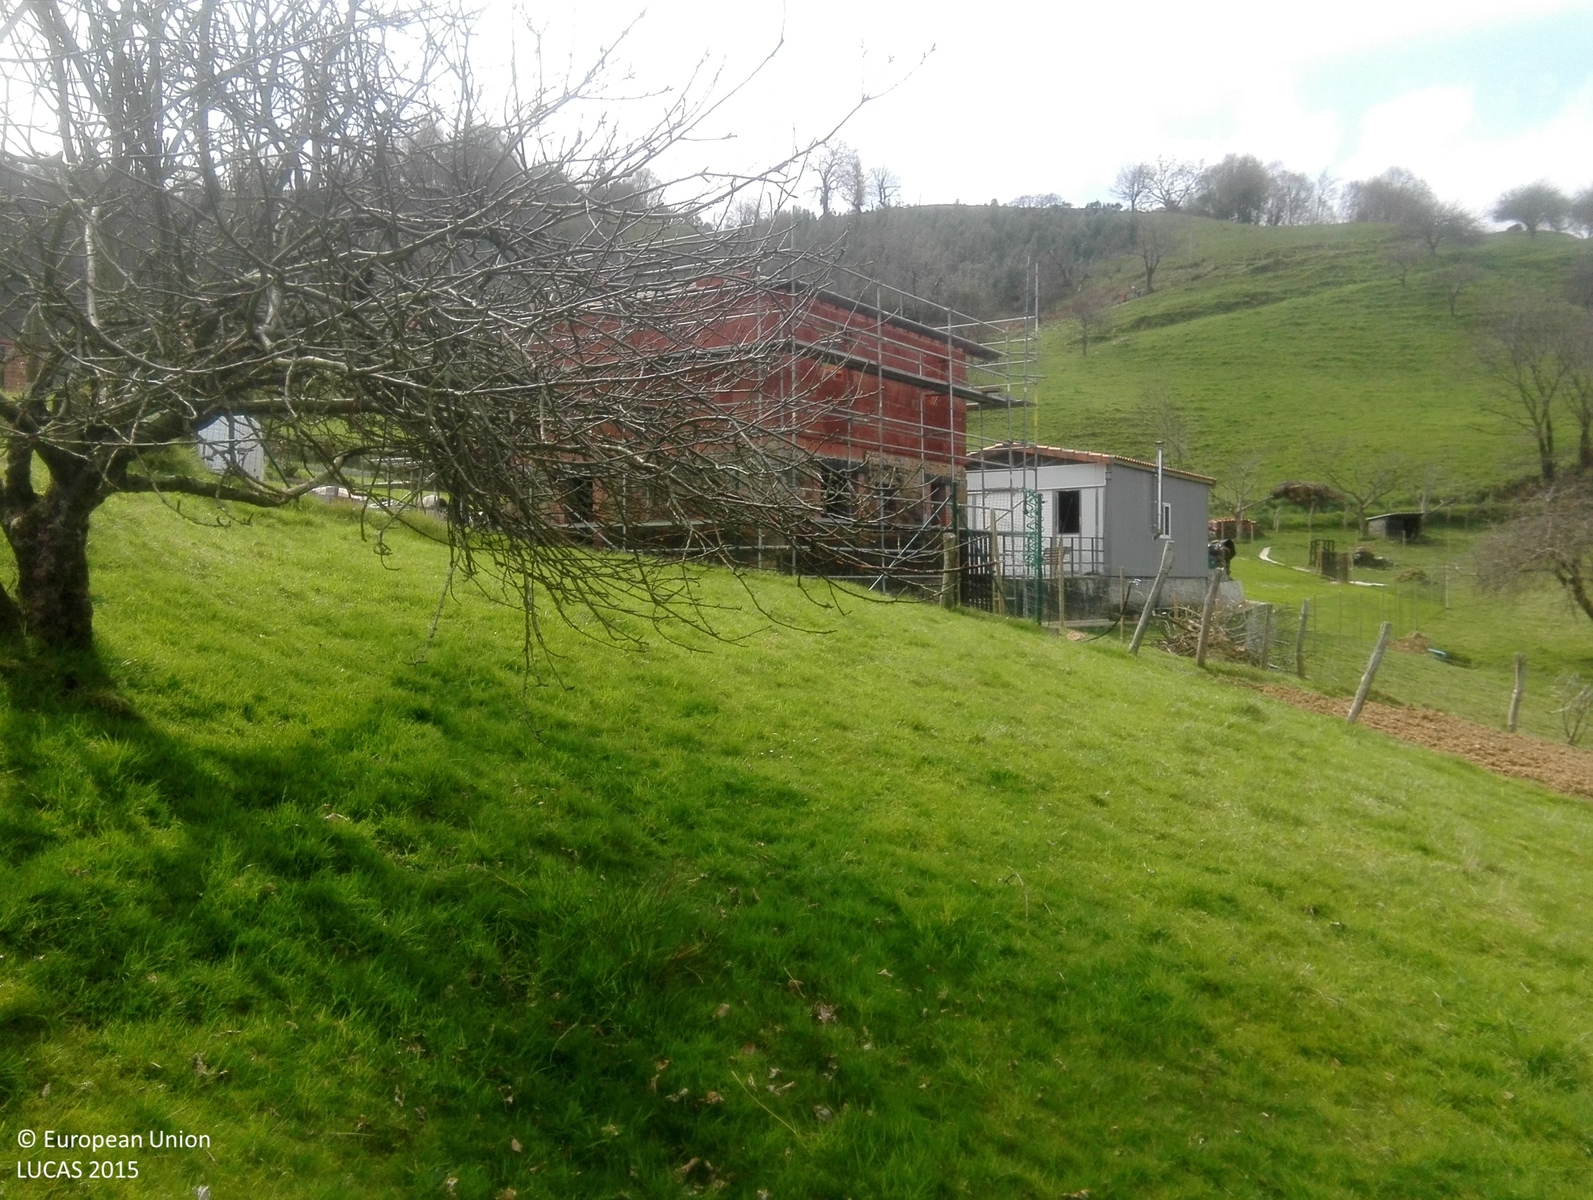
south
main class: Cropland
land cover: Apple fruit
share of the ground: 50 - 75 %
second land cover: Grassland without tree/shrub cover
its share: > 75 %
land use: Agriculture (excluding fallow land and kitchen gardens)
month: April
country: ES
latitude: 43.4667
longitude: -5.6465
